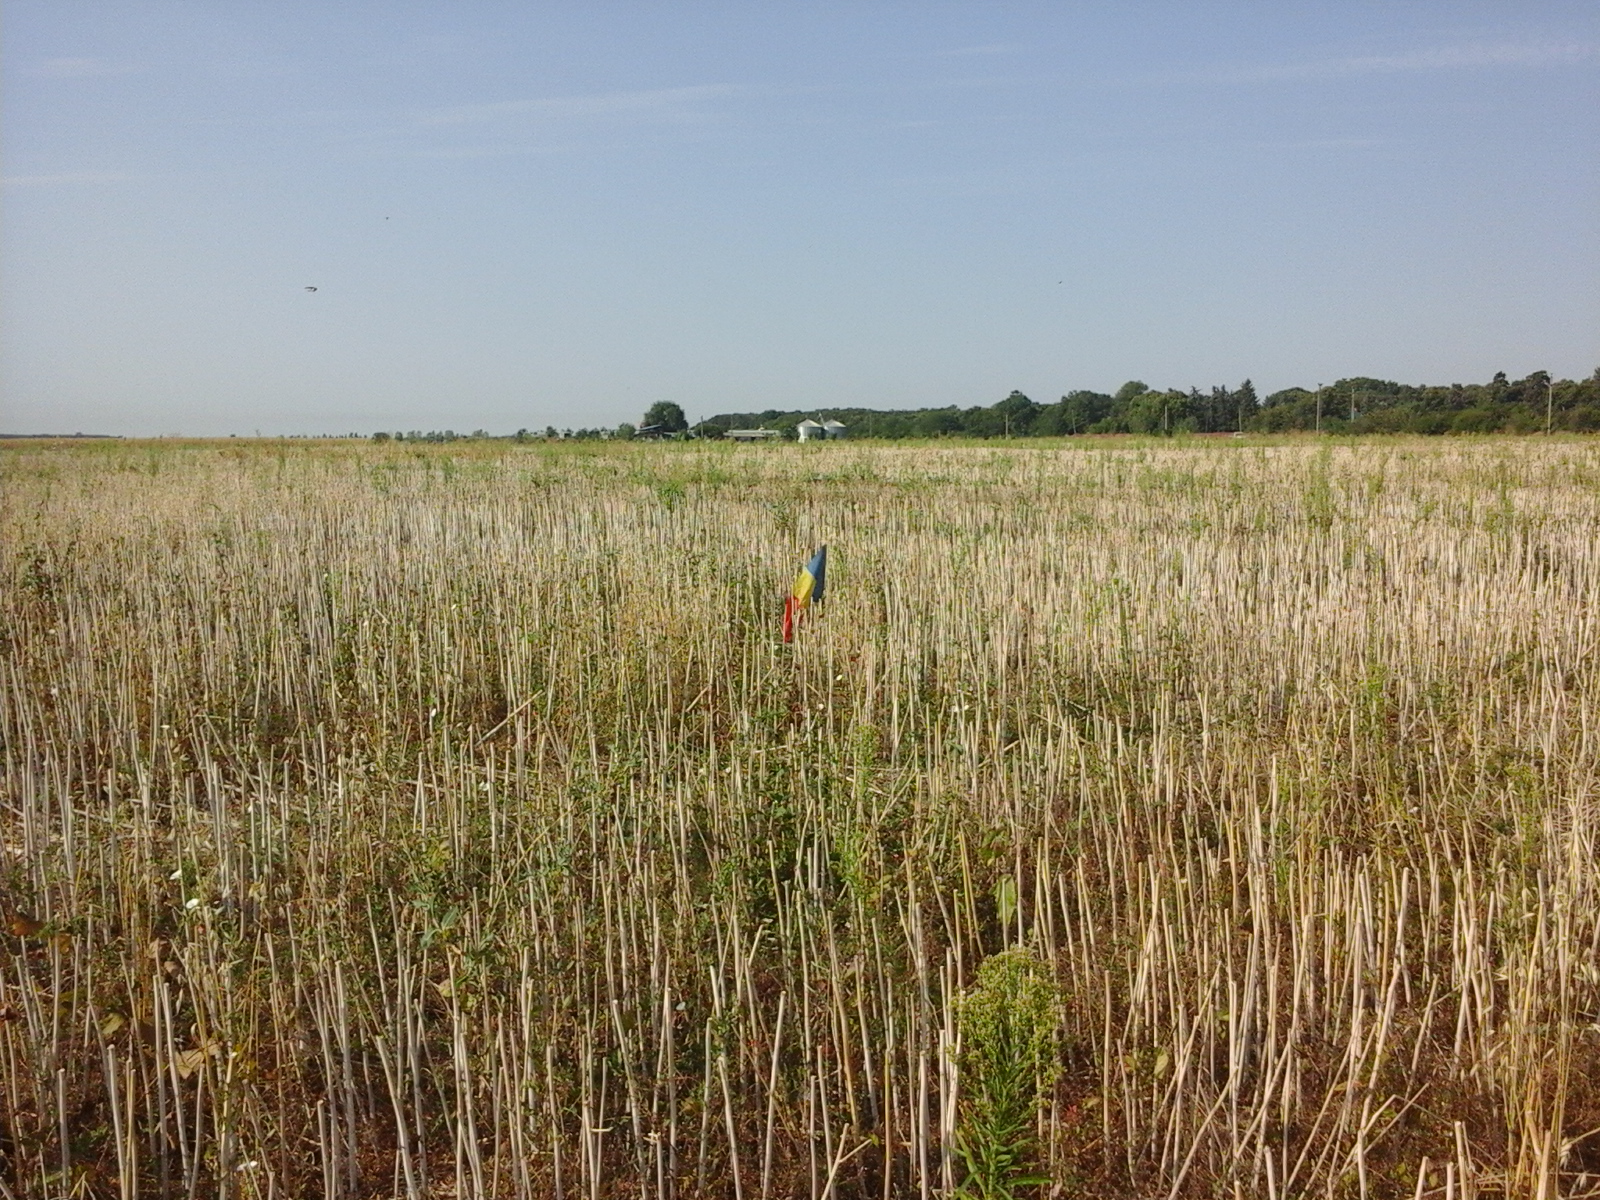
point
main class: Cropland
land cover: Rape and turnip rape
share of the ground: > 75 %
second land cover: Spontaneously vegetated surfaces
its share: 50 - 75 %
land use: Agriculture (excluding fallow land and kitchen gardens)
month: August
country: RO
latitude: 44.1439
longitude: 23.7431
